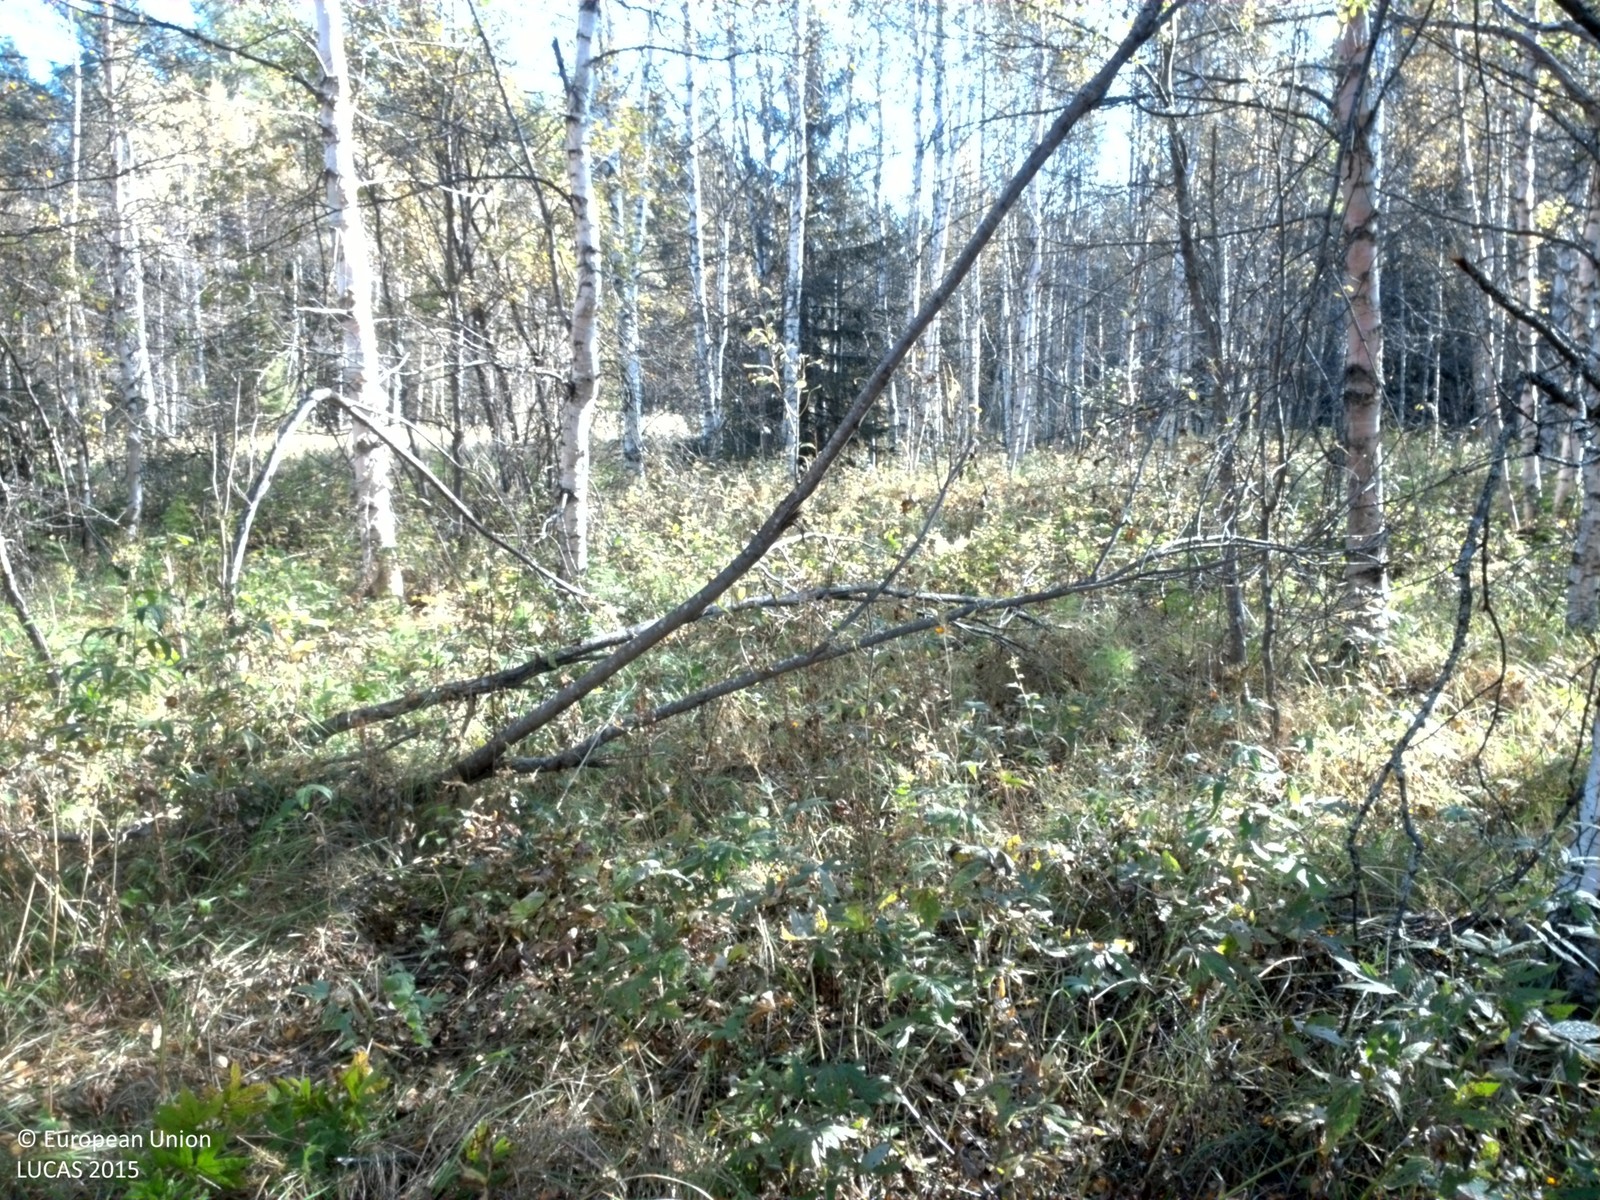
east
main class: Woodland
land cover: Broadleaved woodland
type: floodplain forest
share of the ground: 25 - 50 %
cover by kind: shrubs 40 %, broadleaved forest trees 30 %, herbaceous plants 30 %
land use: Forestry
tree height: > 5 m
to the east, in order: Broadleaved woodland; Ditches and canals; Broadleaved woodland; Grassland without tree/shrub cover; Broadleaved woodland; Spruce dominated mixed woodland; Grassland without tree/shrub cover; Broadleaved woodland
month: September
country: SE
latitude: 65.8878
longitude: 22.1952
